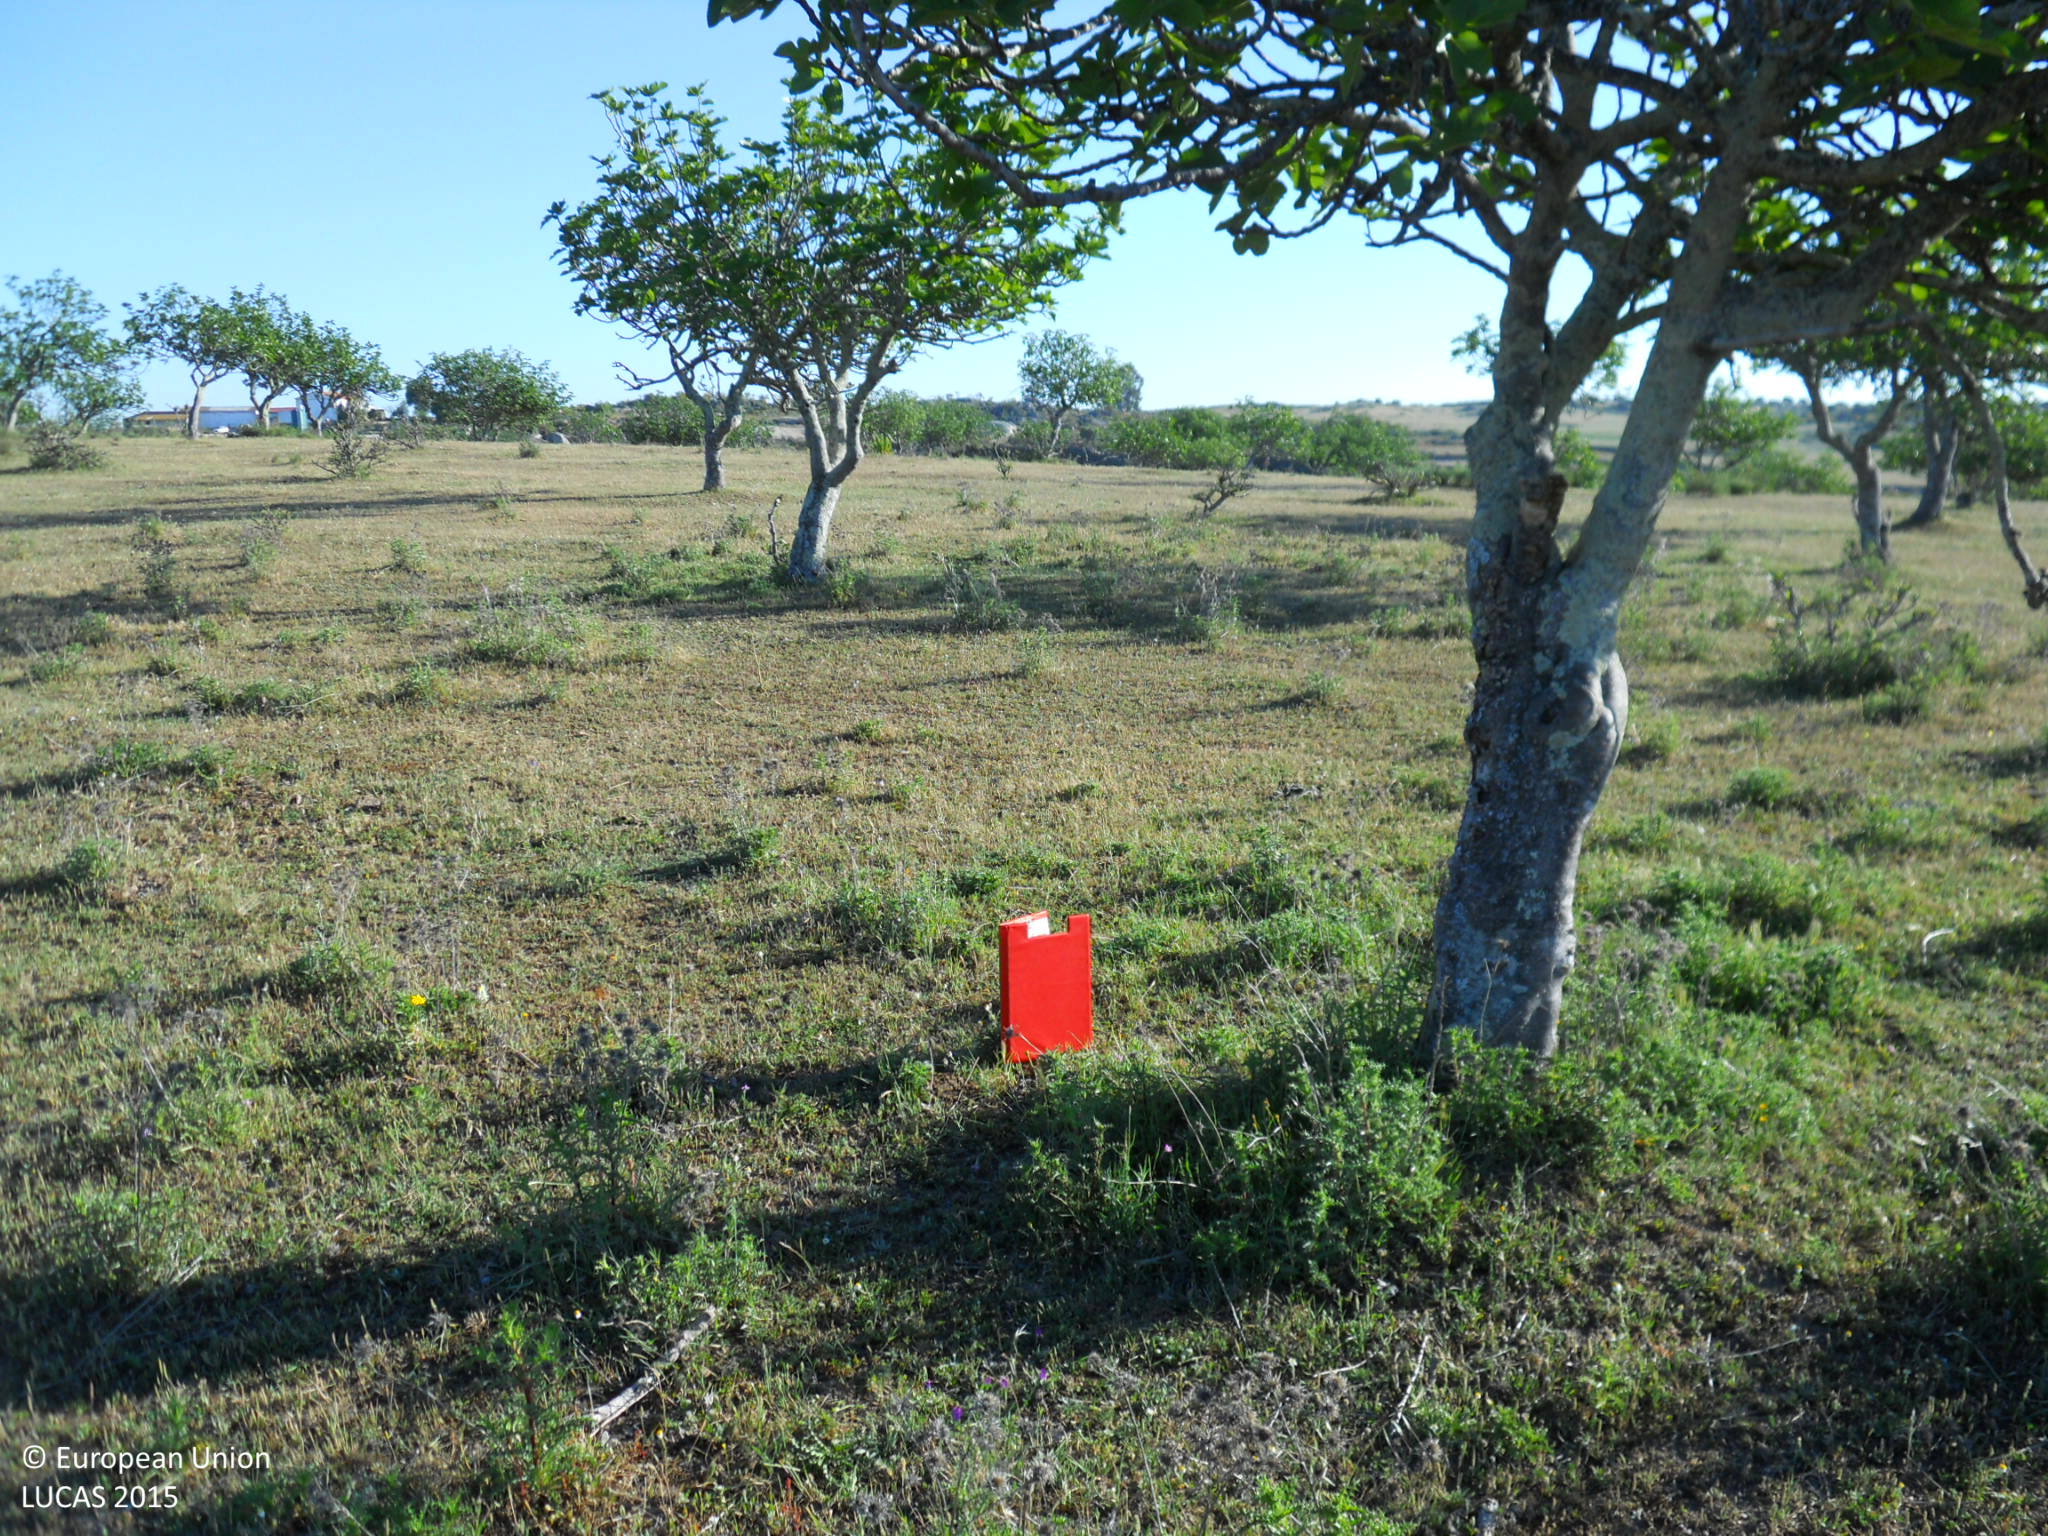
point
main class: Cropland
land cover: Other fruit trees and berries
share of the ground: 25 - 50 %
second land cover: Spontaneously vegetated surfaces
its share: > 75 %
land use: Agriculture (excluding fallow land and kitchen gardens)
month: April
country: ES
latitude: 39.2849
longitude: -7.0161
